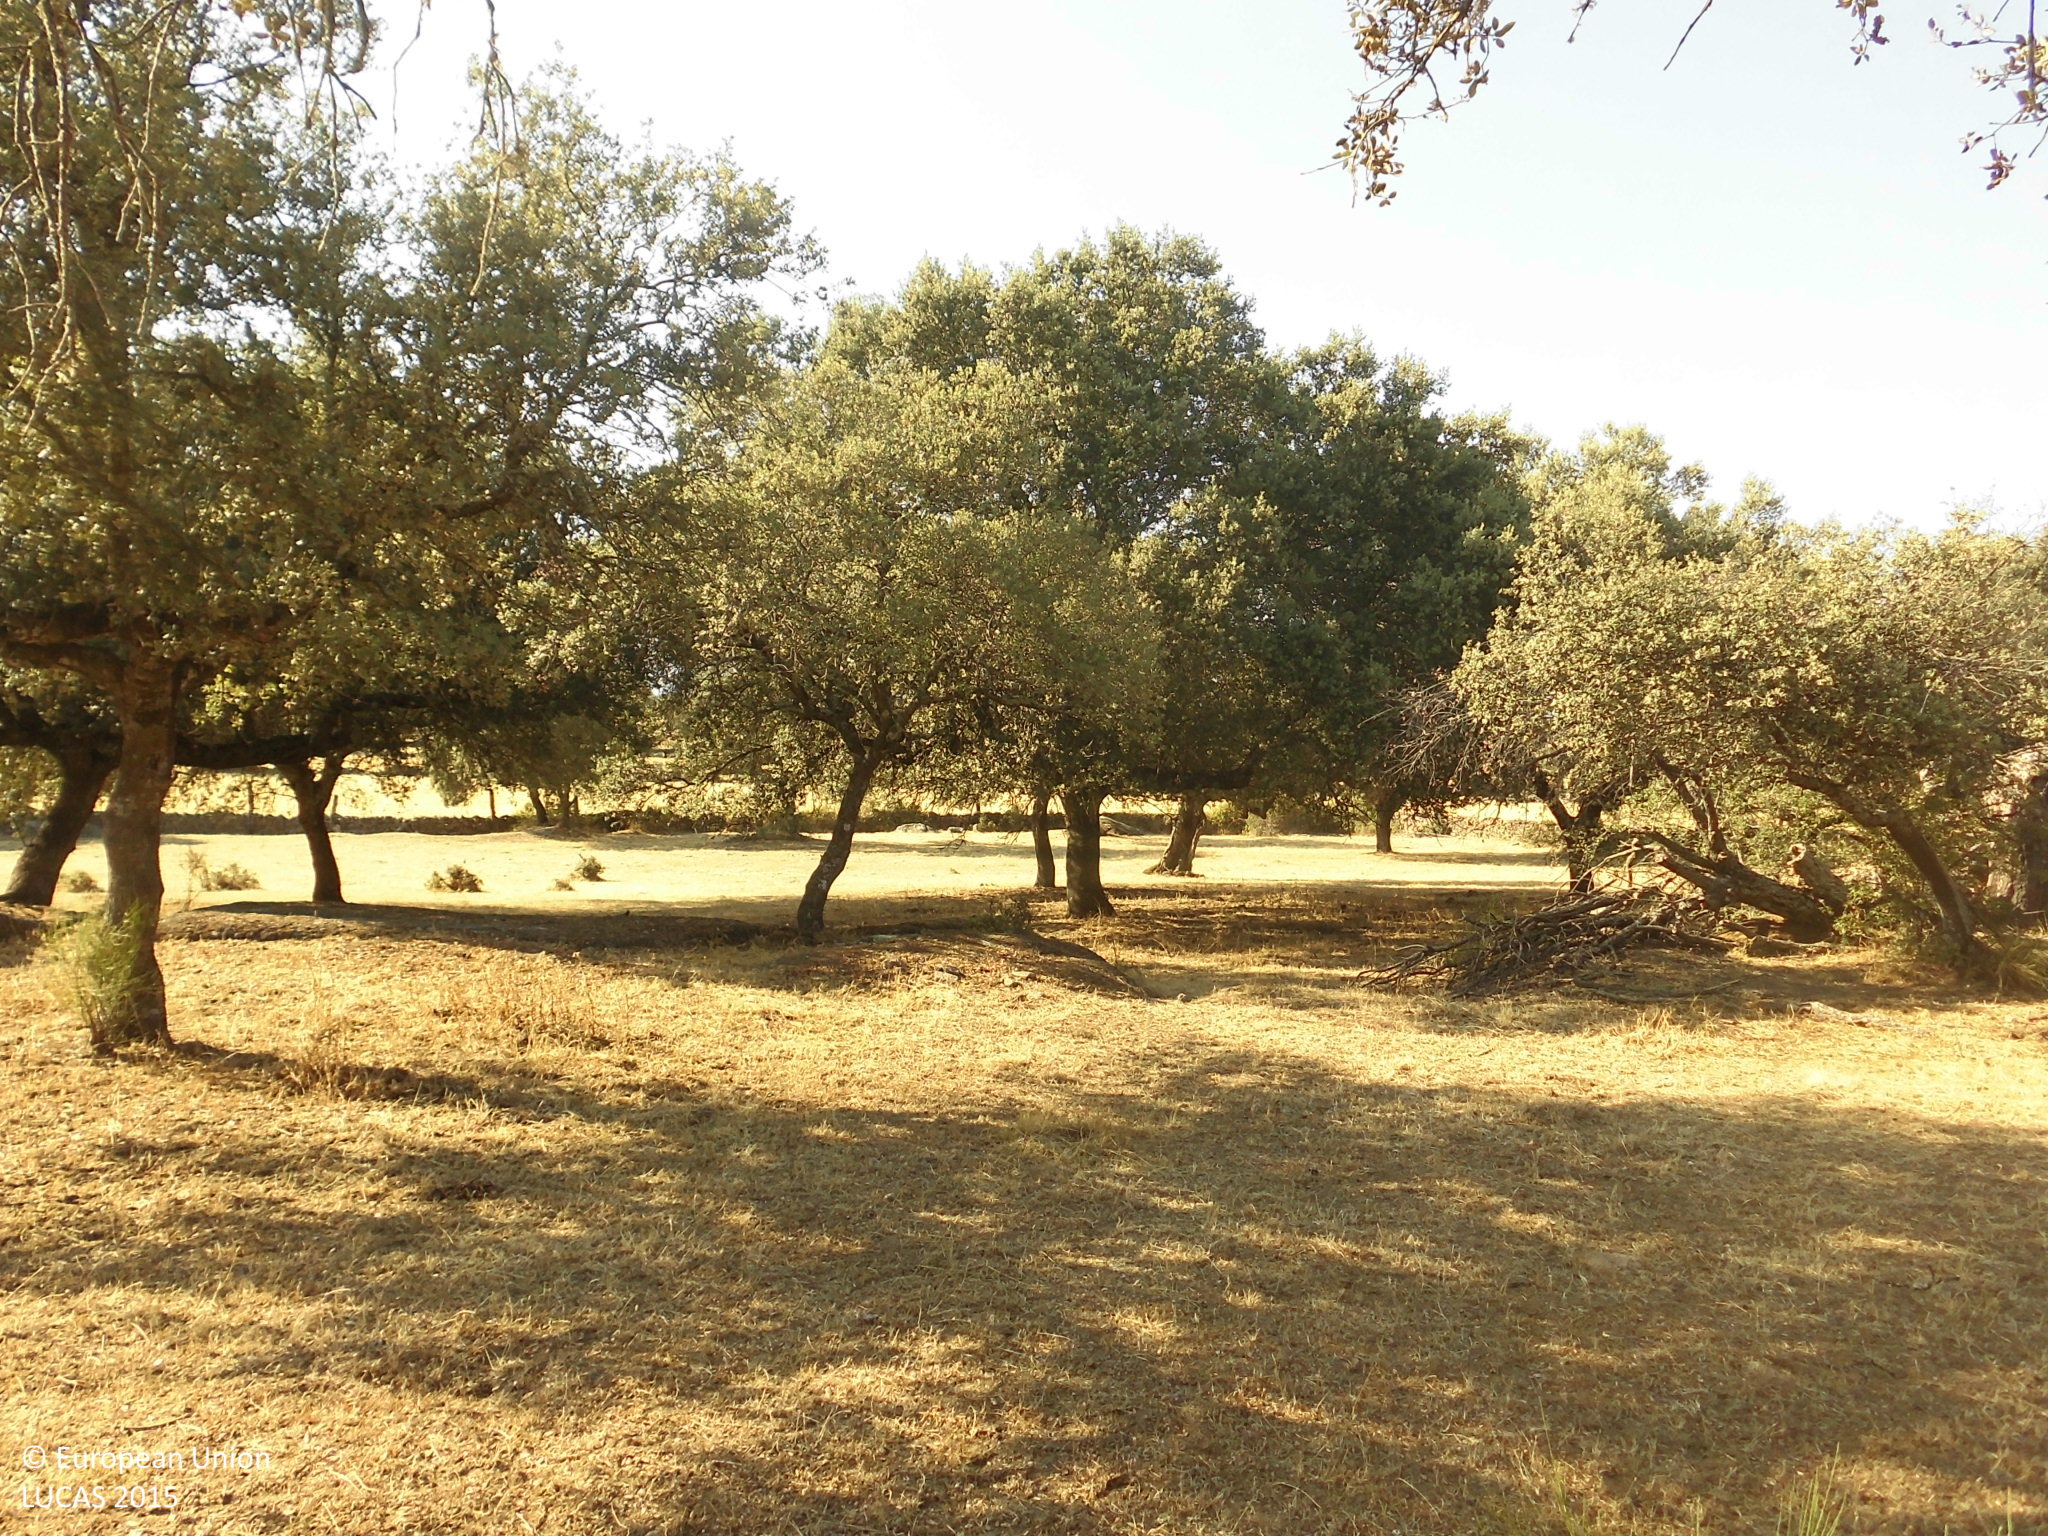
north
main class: Woodland
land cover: Broadleaved woodland
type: broadleaved evergreen forest
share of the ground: 25 - 50 %
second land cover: Grassland without tree/shrub cover
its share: > 75 %
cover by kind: herbaceous plants 70 %, broadleaved forest trees 30 %
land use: Forestry
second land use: Agriculture (excluding fallow land and kitchen gardens)
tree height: > 5 m
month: July
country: ES
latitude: 40.1317
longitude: -6.1645
